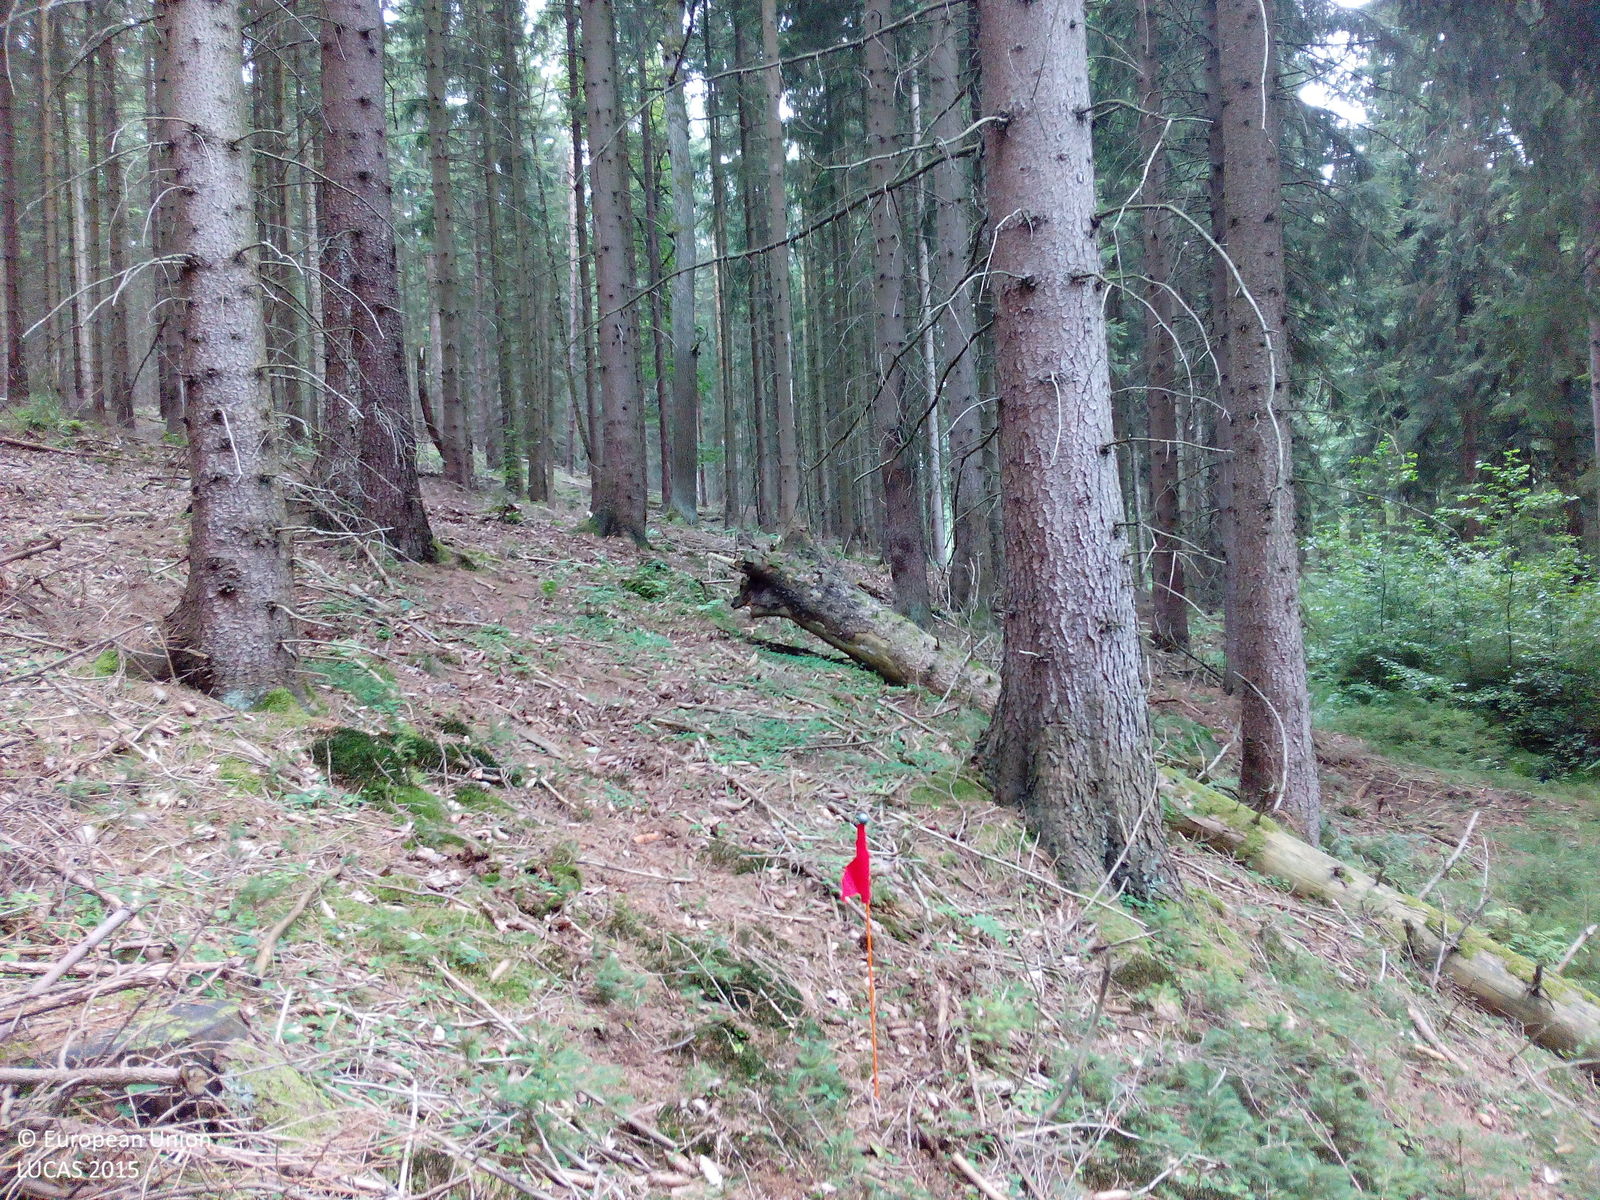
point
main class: Woodland
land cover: Spruce dominated coniferous woodland
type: hemiboreal forest and nemoral coniferous forest and mixed broadleaved-coniferous forest
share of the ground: > 75 %
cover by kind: coniferous forest trees 80 %, herbaceous plants 10 %, lichens and mosses 10 %
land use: Forestry
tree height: > 5 m
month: August
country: DE
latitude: 51.7074
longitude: 11.0850
